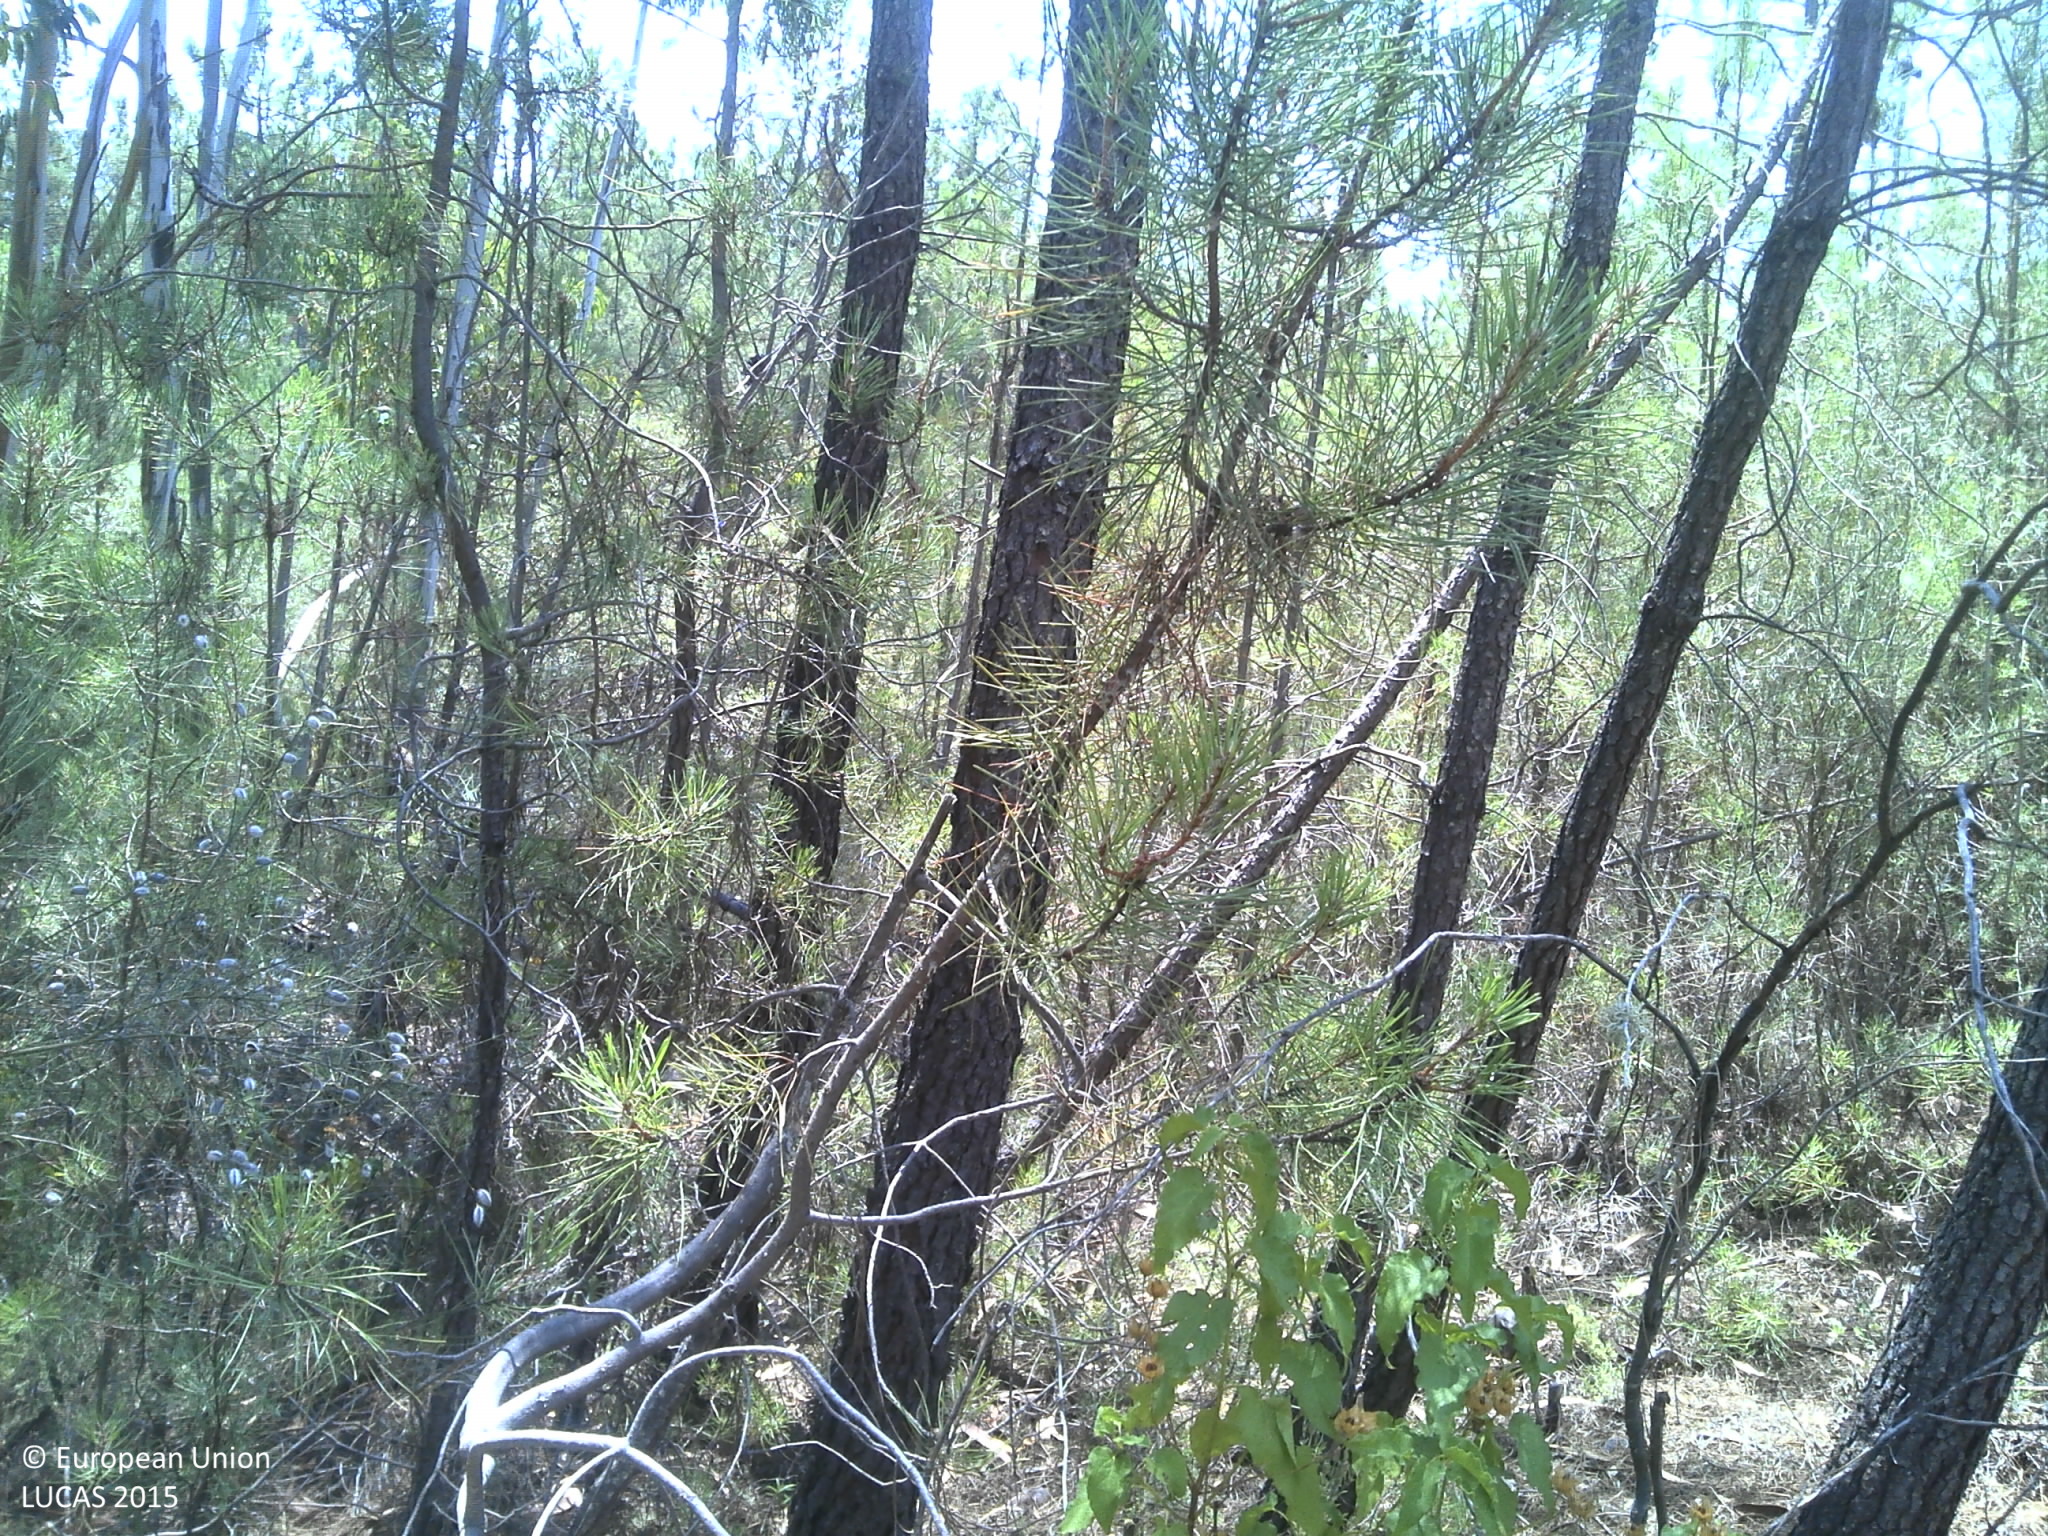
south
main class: Woodland
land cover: Pine dominated coniferous woodland
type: coniferous forest of the mediterranean region
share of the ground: > 75 %
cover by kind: coniferous forest trees 75 %, shrubs 15 %, unconsolidated bare surface 5 %
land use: Forestry
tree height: > 5 m
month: June
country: PT
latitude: 39.9469
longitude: -7.0262
